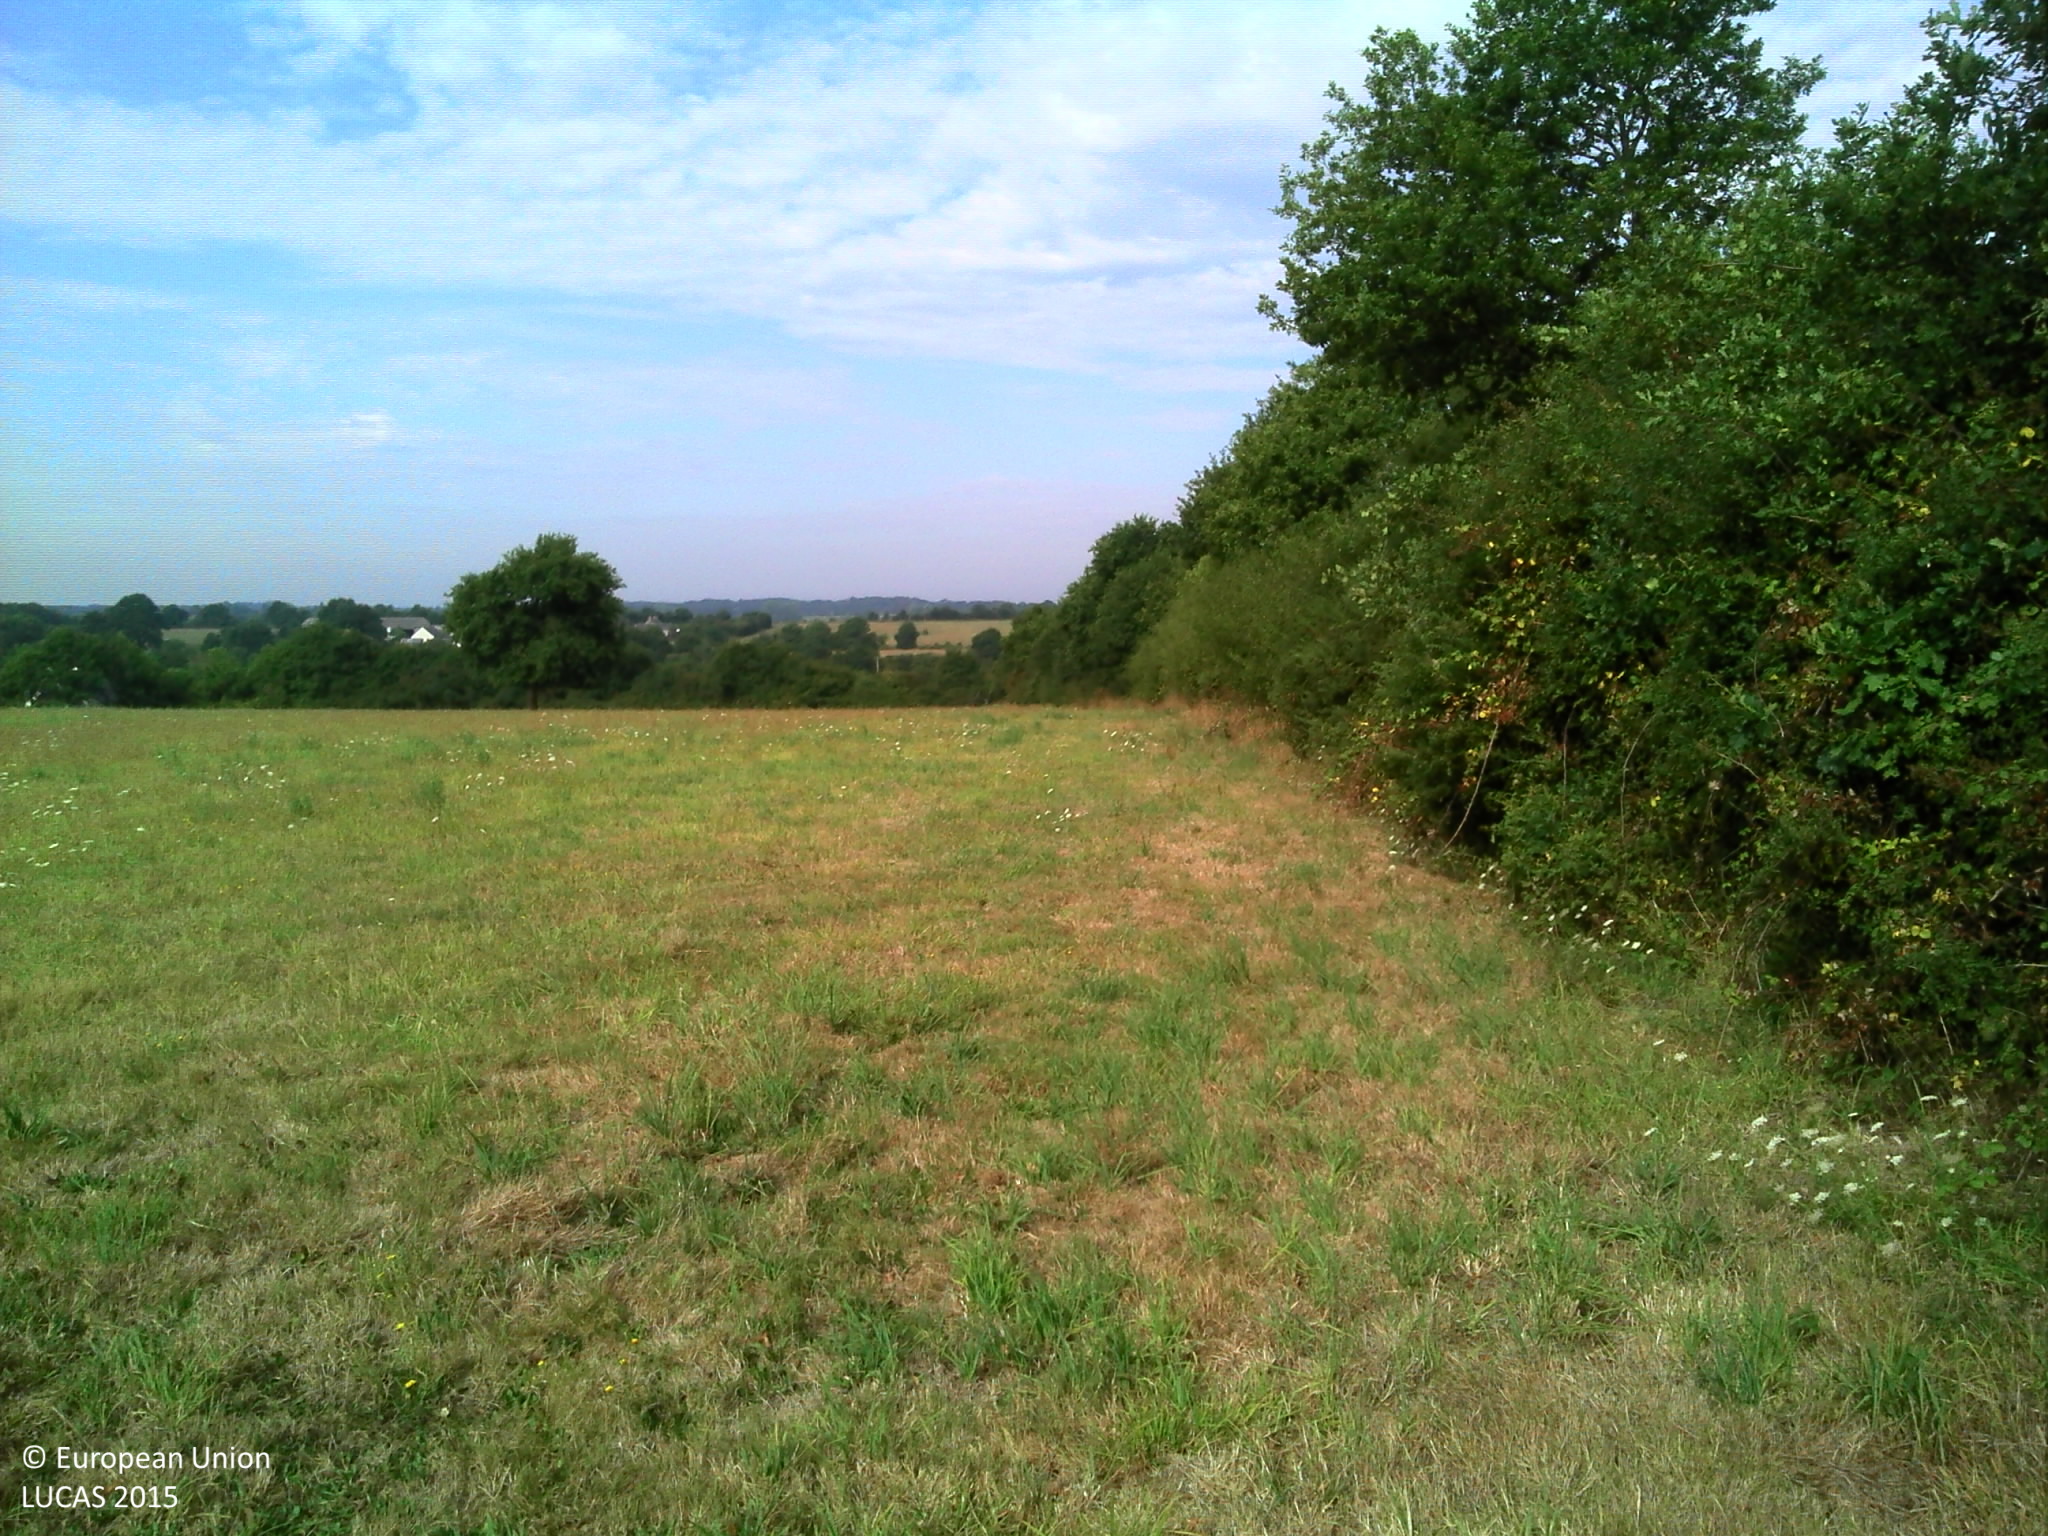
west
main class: Grassland
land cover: Grassland without tree/shrub cover
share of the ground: > 75 %
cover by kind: herbaceous plants 100 %
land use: Agriculture (excluding fallow land and kitchen gardens)
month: August
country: FR
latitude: 47.4054
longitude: -1.8004
